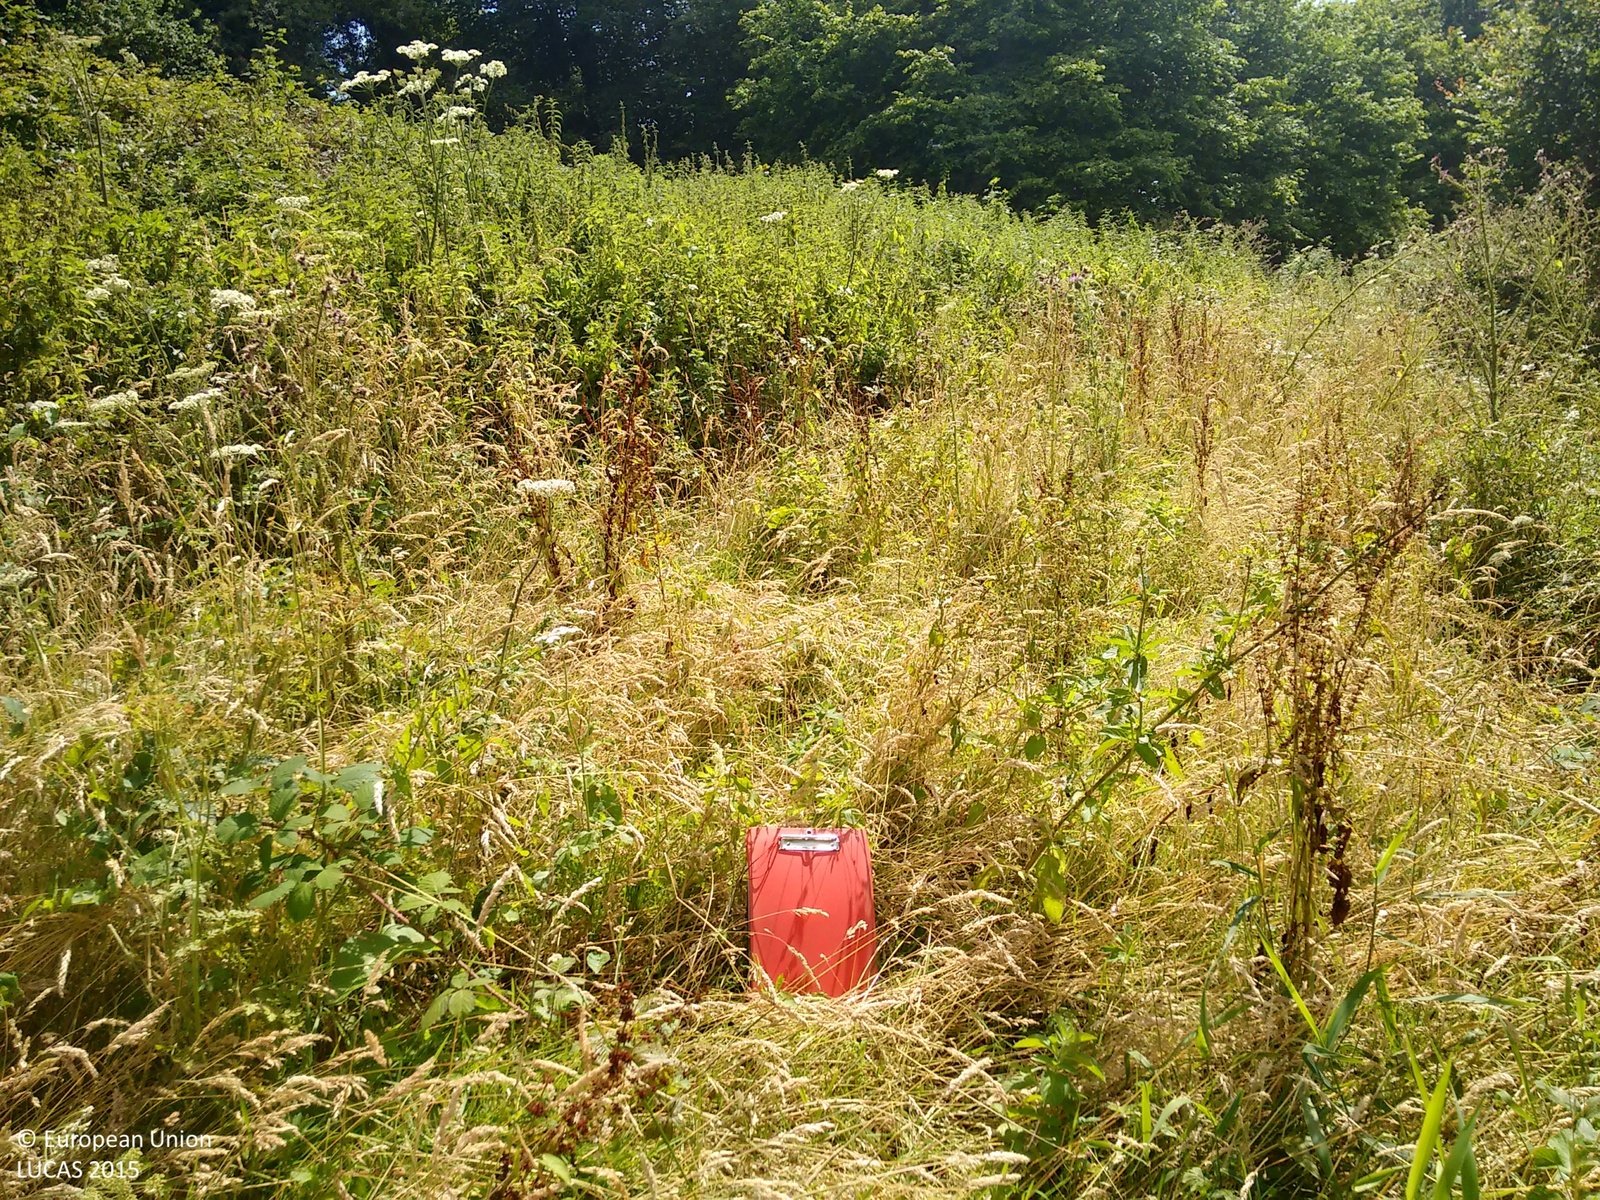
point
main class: Shrubland
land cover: Shrubland without tree cover
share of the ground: > 75 %
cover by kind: shrubs 80 %, herbaceous plants 20 %
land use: Semi-natural and natural areas not in use
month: August
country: GB
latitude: 50.3631
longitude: -3.9389
